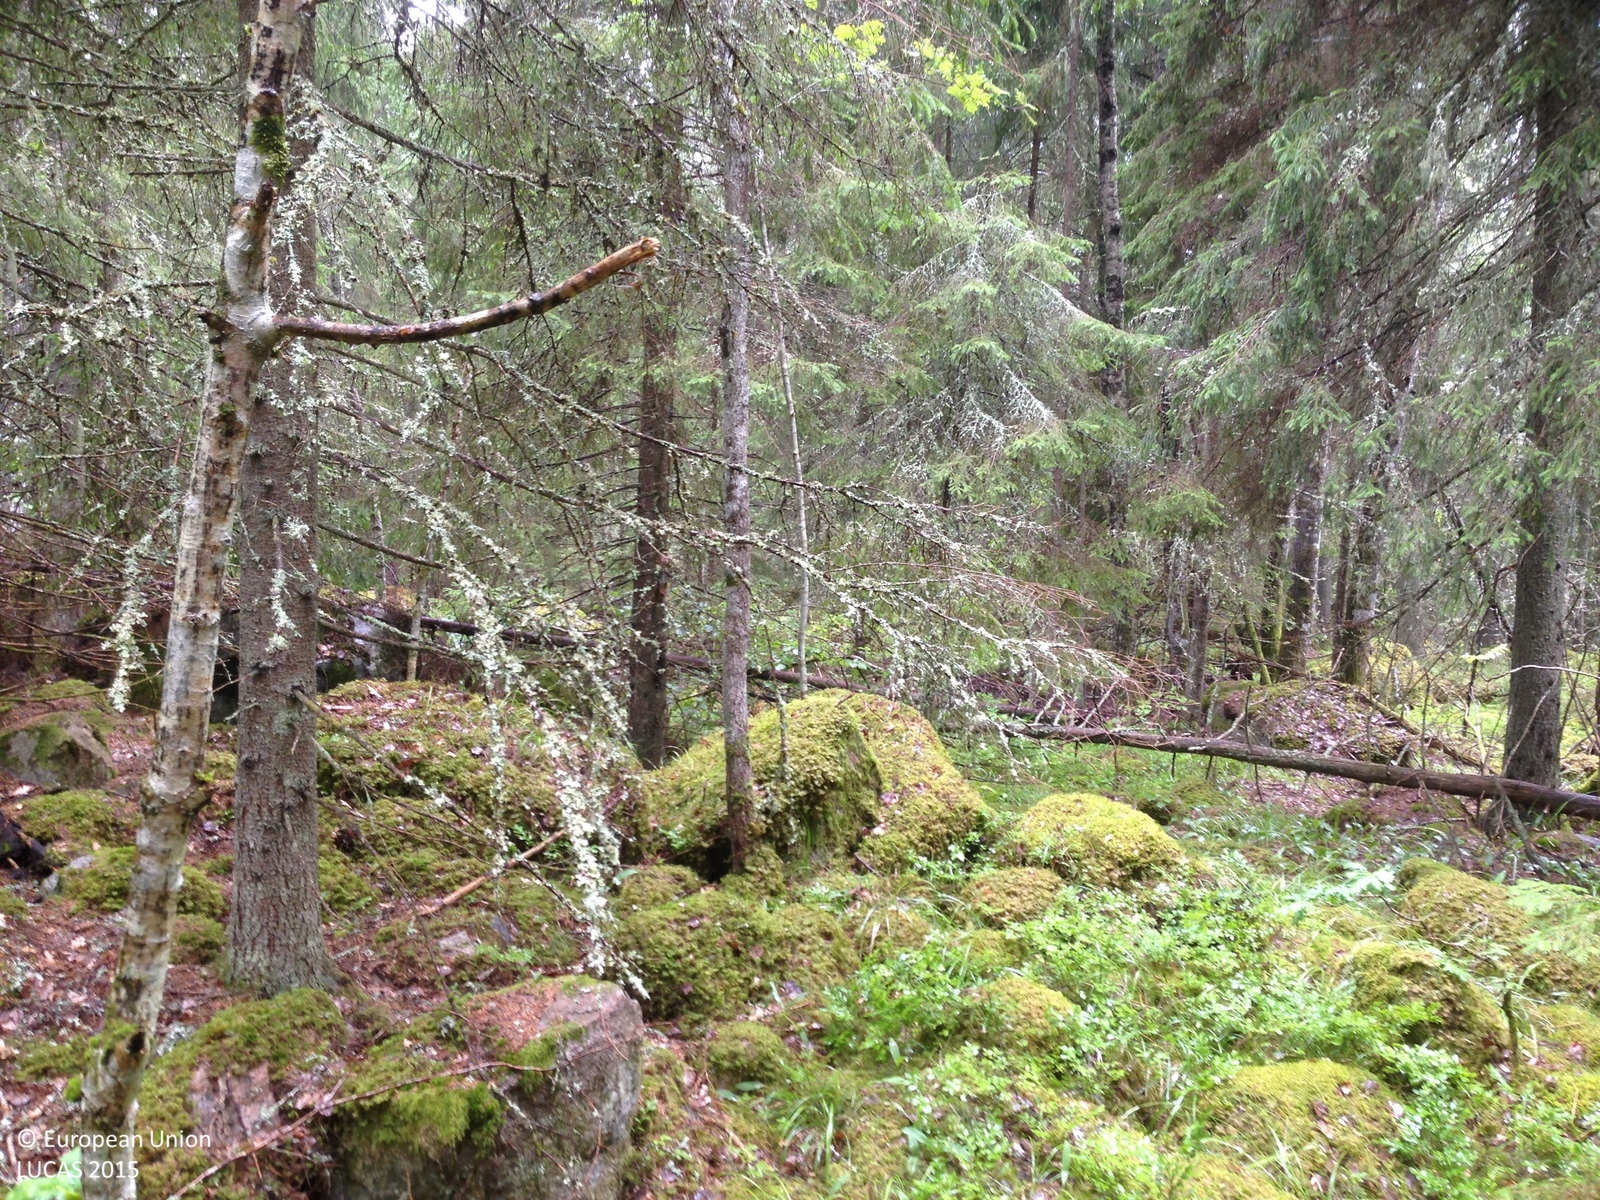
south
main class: Woodland
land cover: Spruce dominated coniferous woodland
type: boreal forest
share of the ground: > 75 %
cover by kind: coniferous forest trees 75 %, lichens and mosses 15 %, broadleaved forest trees 10 %
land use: Forestry
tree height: > 5 m
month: July
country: SE
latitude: 59.9334
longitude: 18.6416
